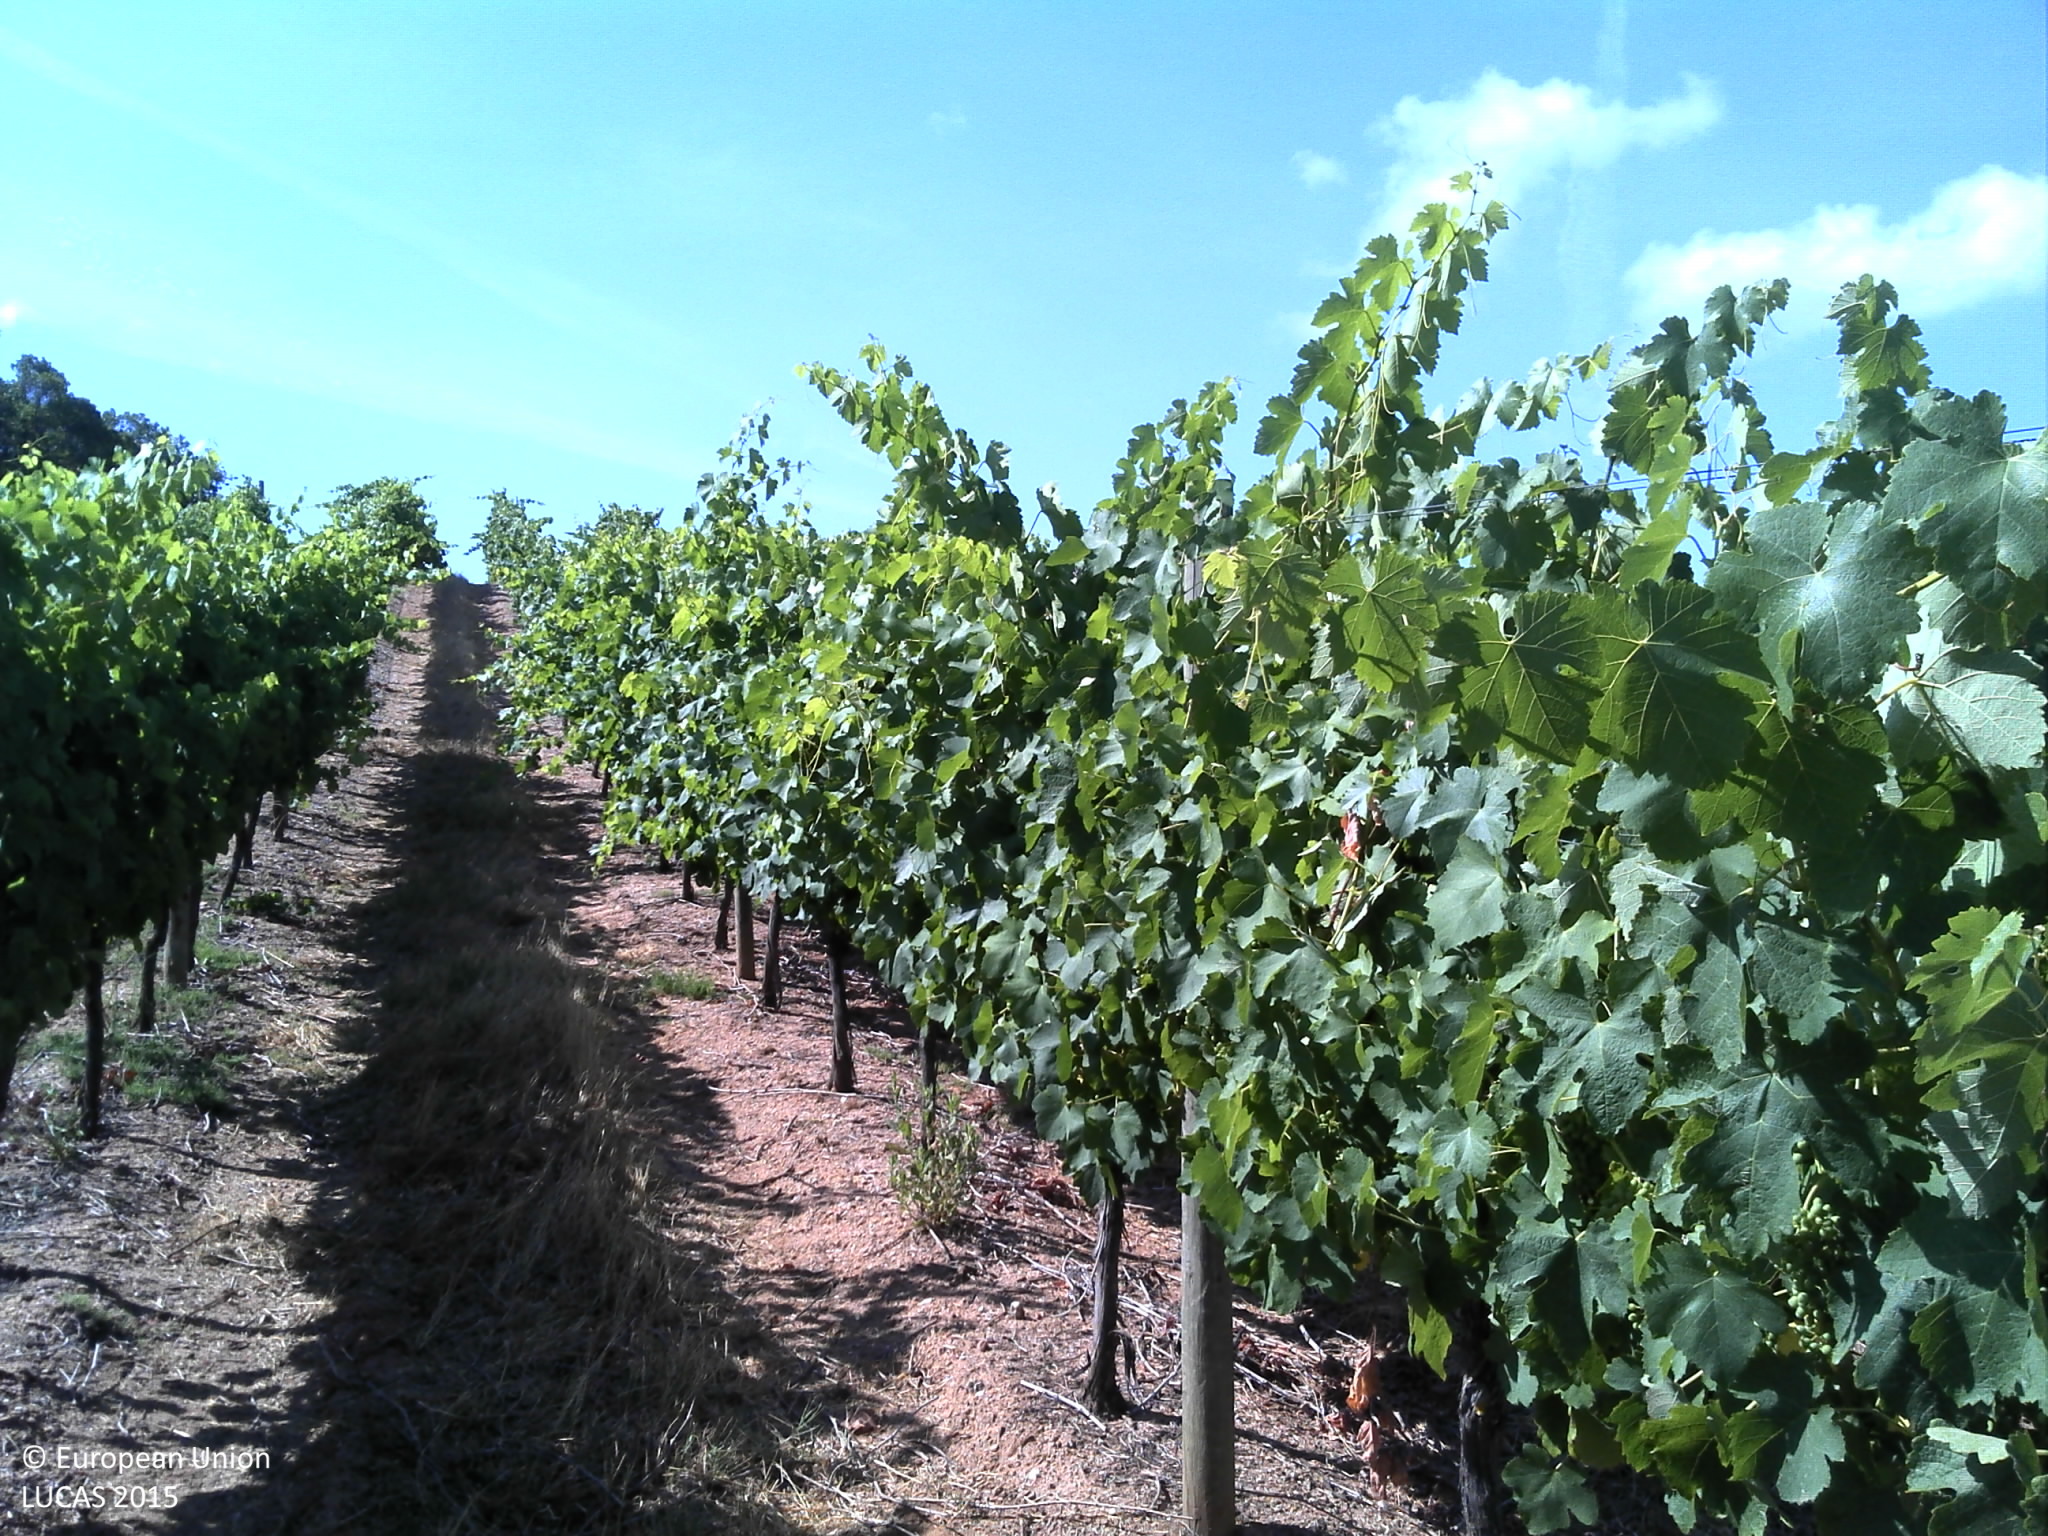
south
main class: Cropland
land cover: Vineyards
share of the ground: 50 - 75 %
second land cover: Grassland without tree/shrub cover
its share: 25 - 50 %
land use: Agriculture (excluding fallow land and kitchen gardens)
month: July
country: PT
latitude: 38.4762
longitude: -9.0379
